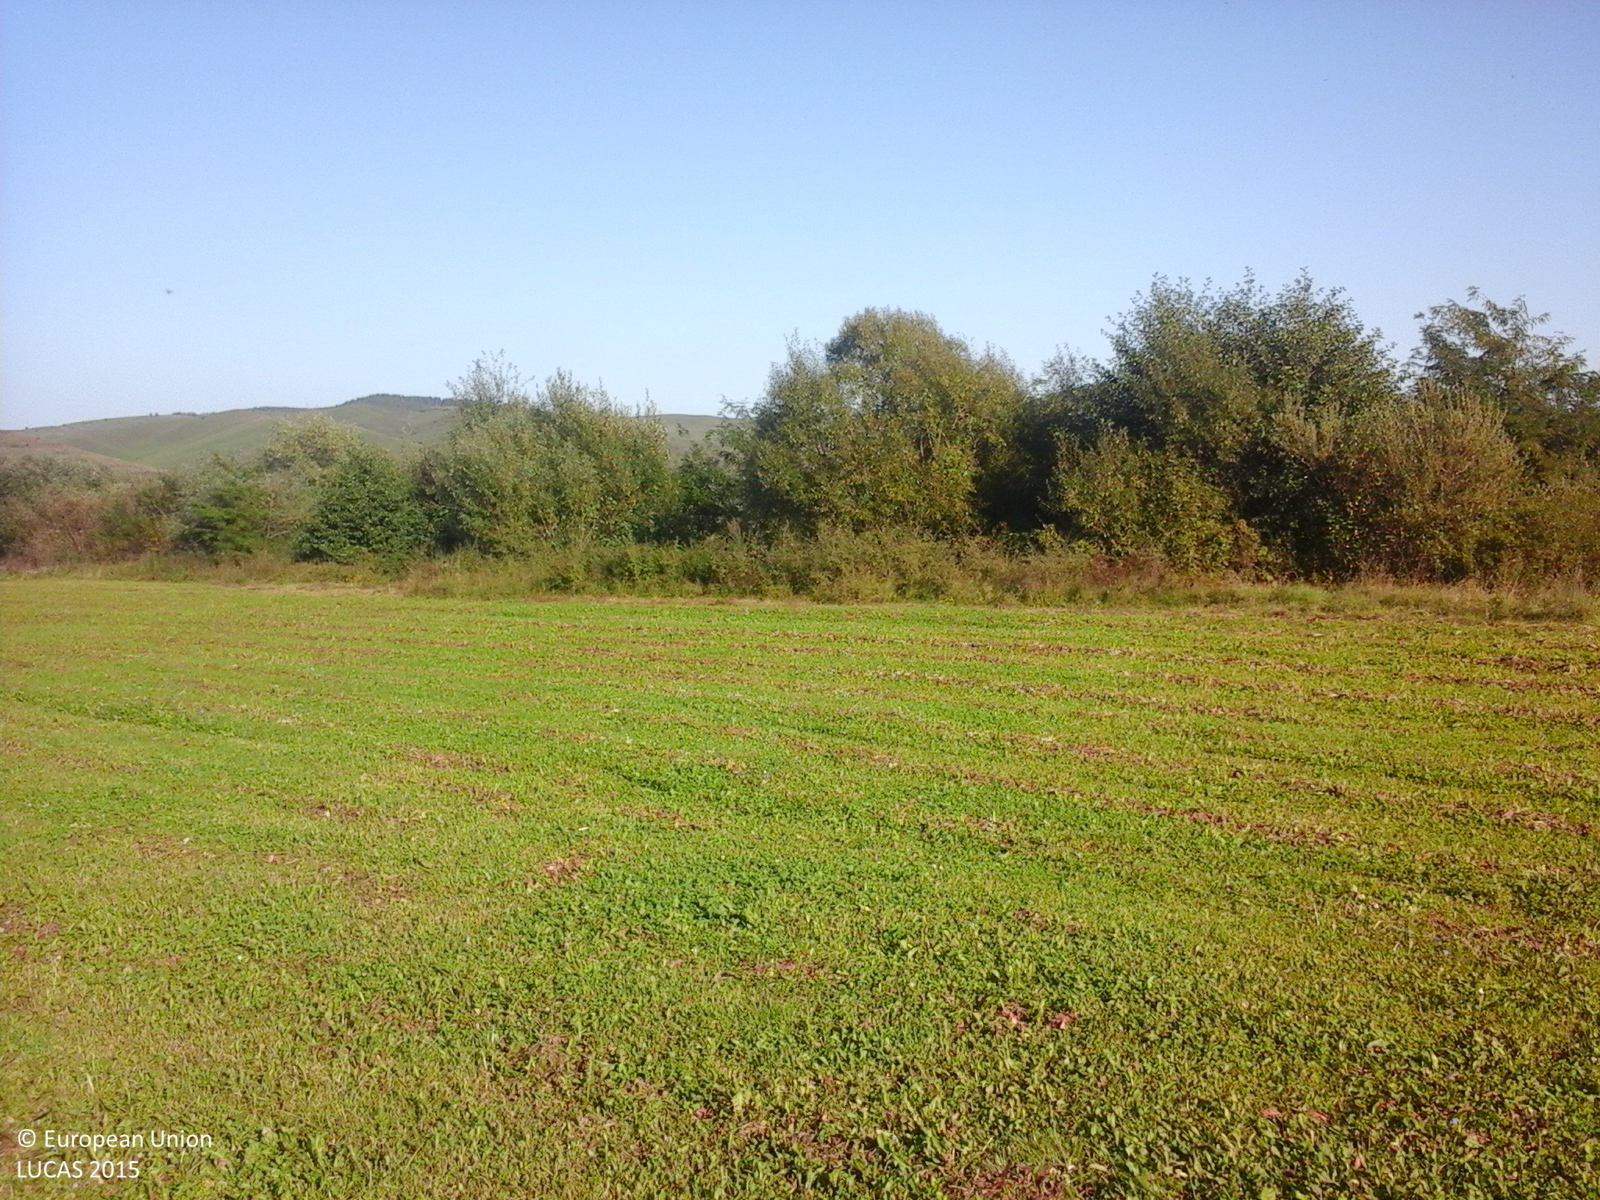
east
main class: Grassland
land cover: Grassland without tree/shrub cover
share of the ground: > 75 %
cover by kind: herbaceous plants 100 %
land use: Agriculture (excluding fallow land and kitchen gardens)
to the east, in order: Grassland without tree/shrub cover; Abandoned hedges; Rivers and streams; Grass margins; Tracks; Grassland without tree/shrub cover; Lucerne; Grassland without tree/shrub cover
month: October
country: RO
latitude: 46.5474
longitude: 23.5141
